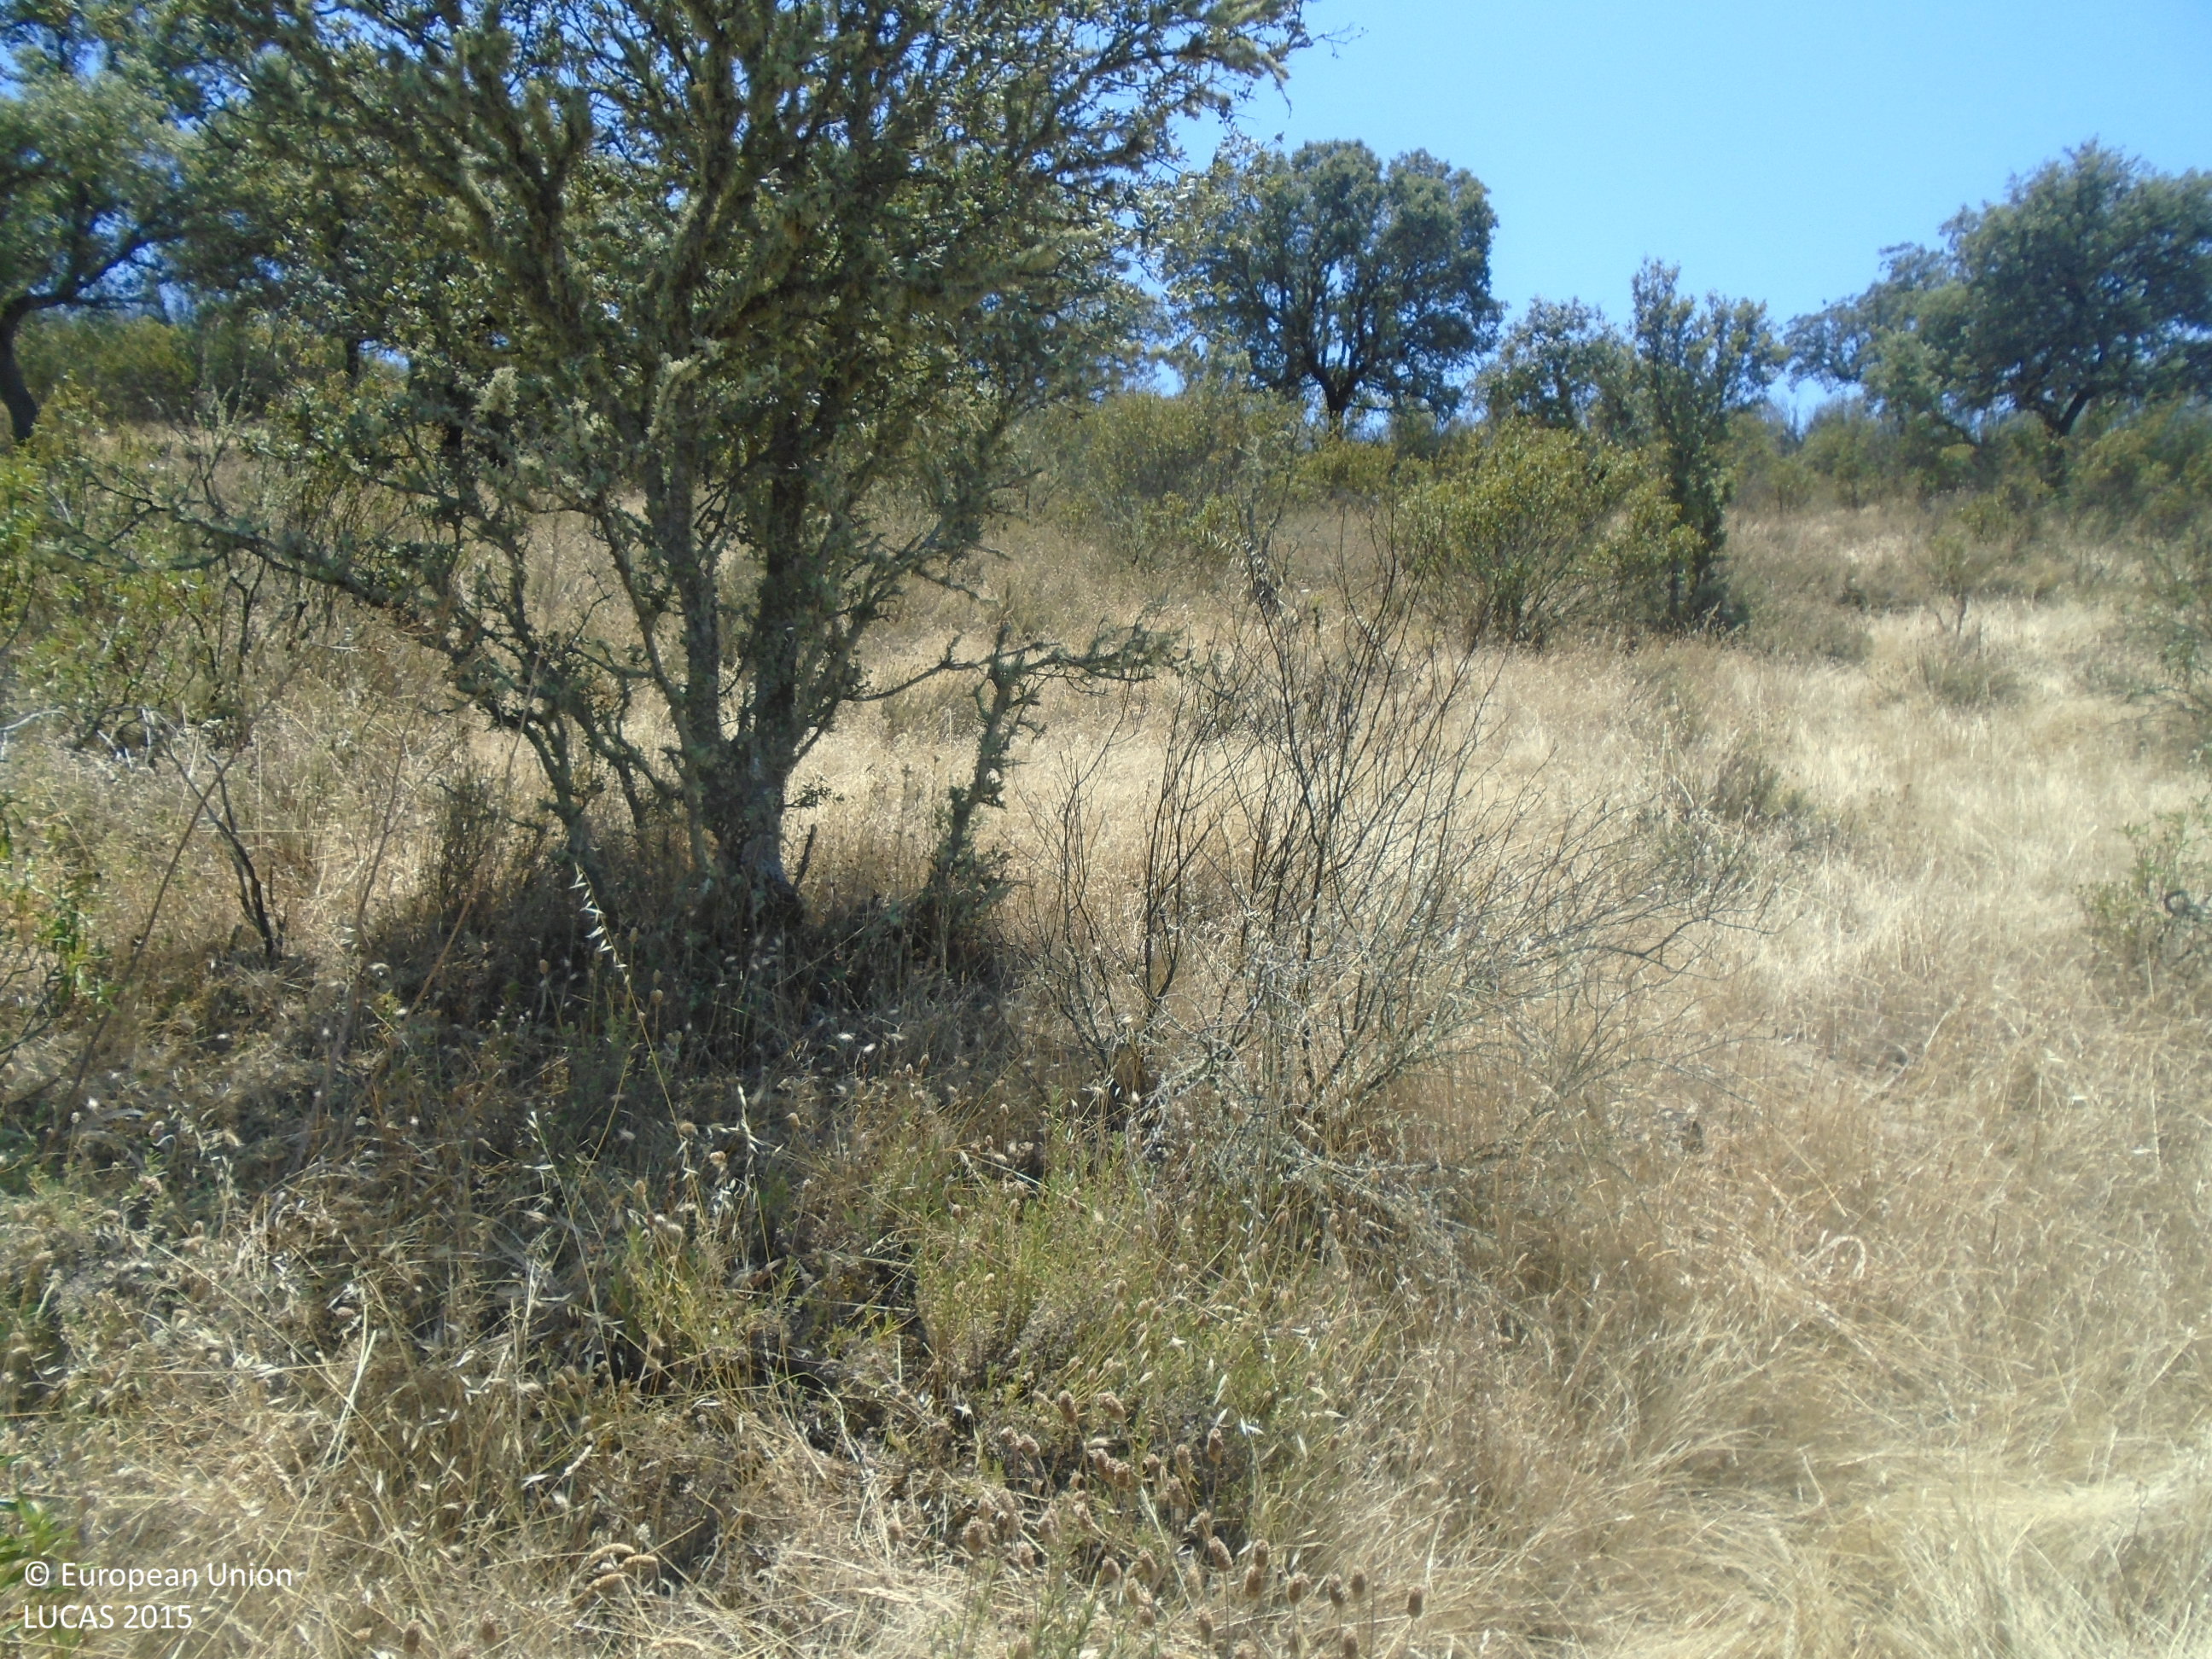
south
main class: Shrubland
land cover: Shrubland with sparse tree cover
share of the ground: > 75 %
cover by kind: shrubs 85 %, broadleaved forest trees 5 %, herbaceous plants 5 %, consolidated bare surface 5 %
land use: Semi-natural and natural areas not in use
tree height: > 5 m
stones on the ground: 10 - 25 %
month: July
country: ES
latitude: 39.4486
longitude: -4.8093
